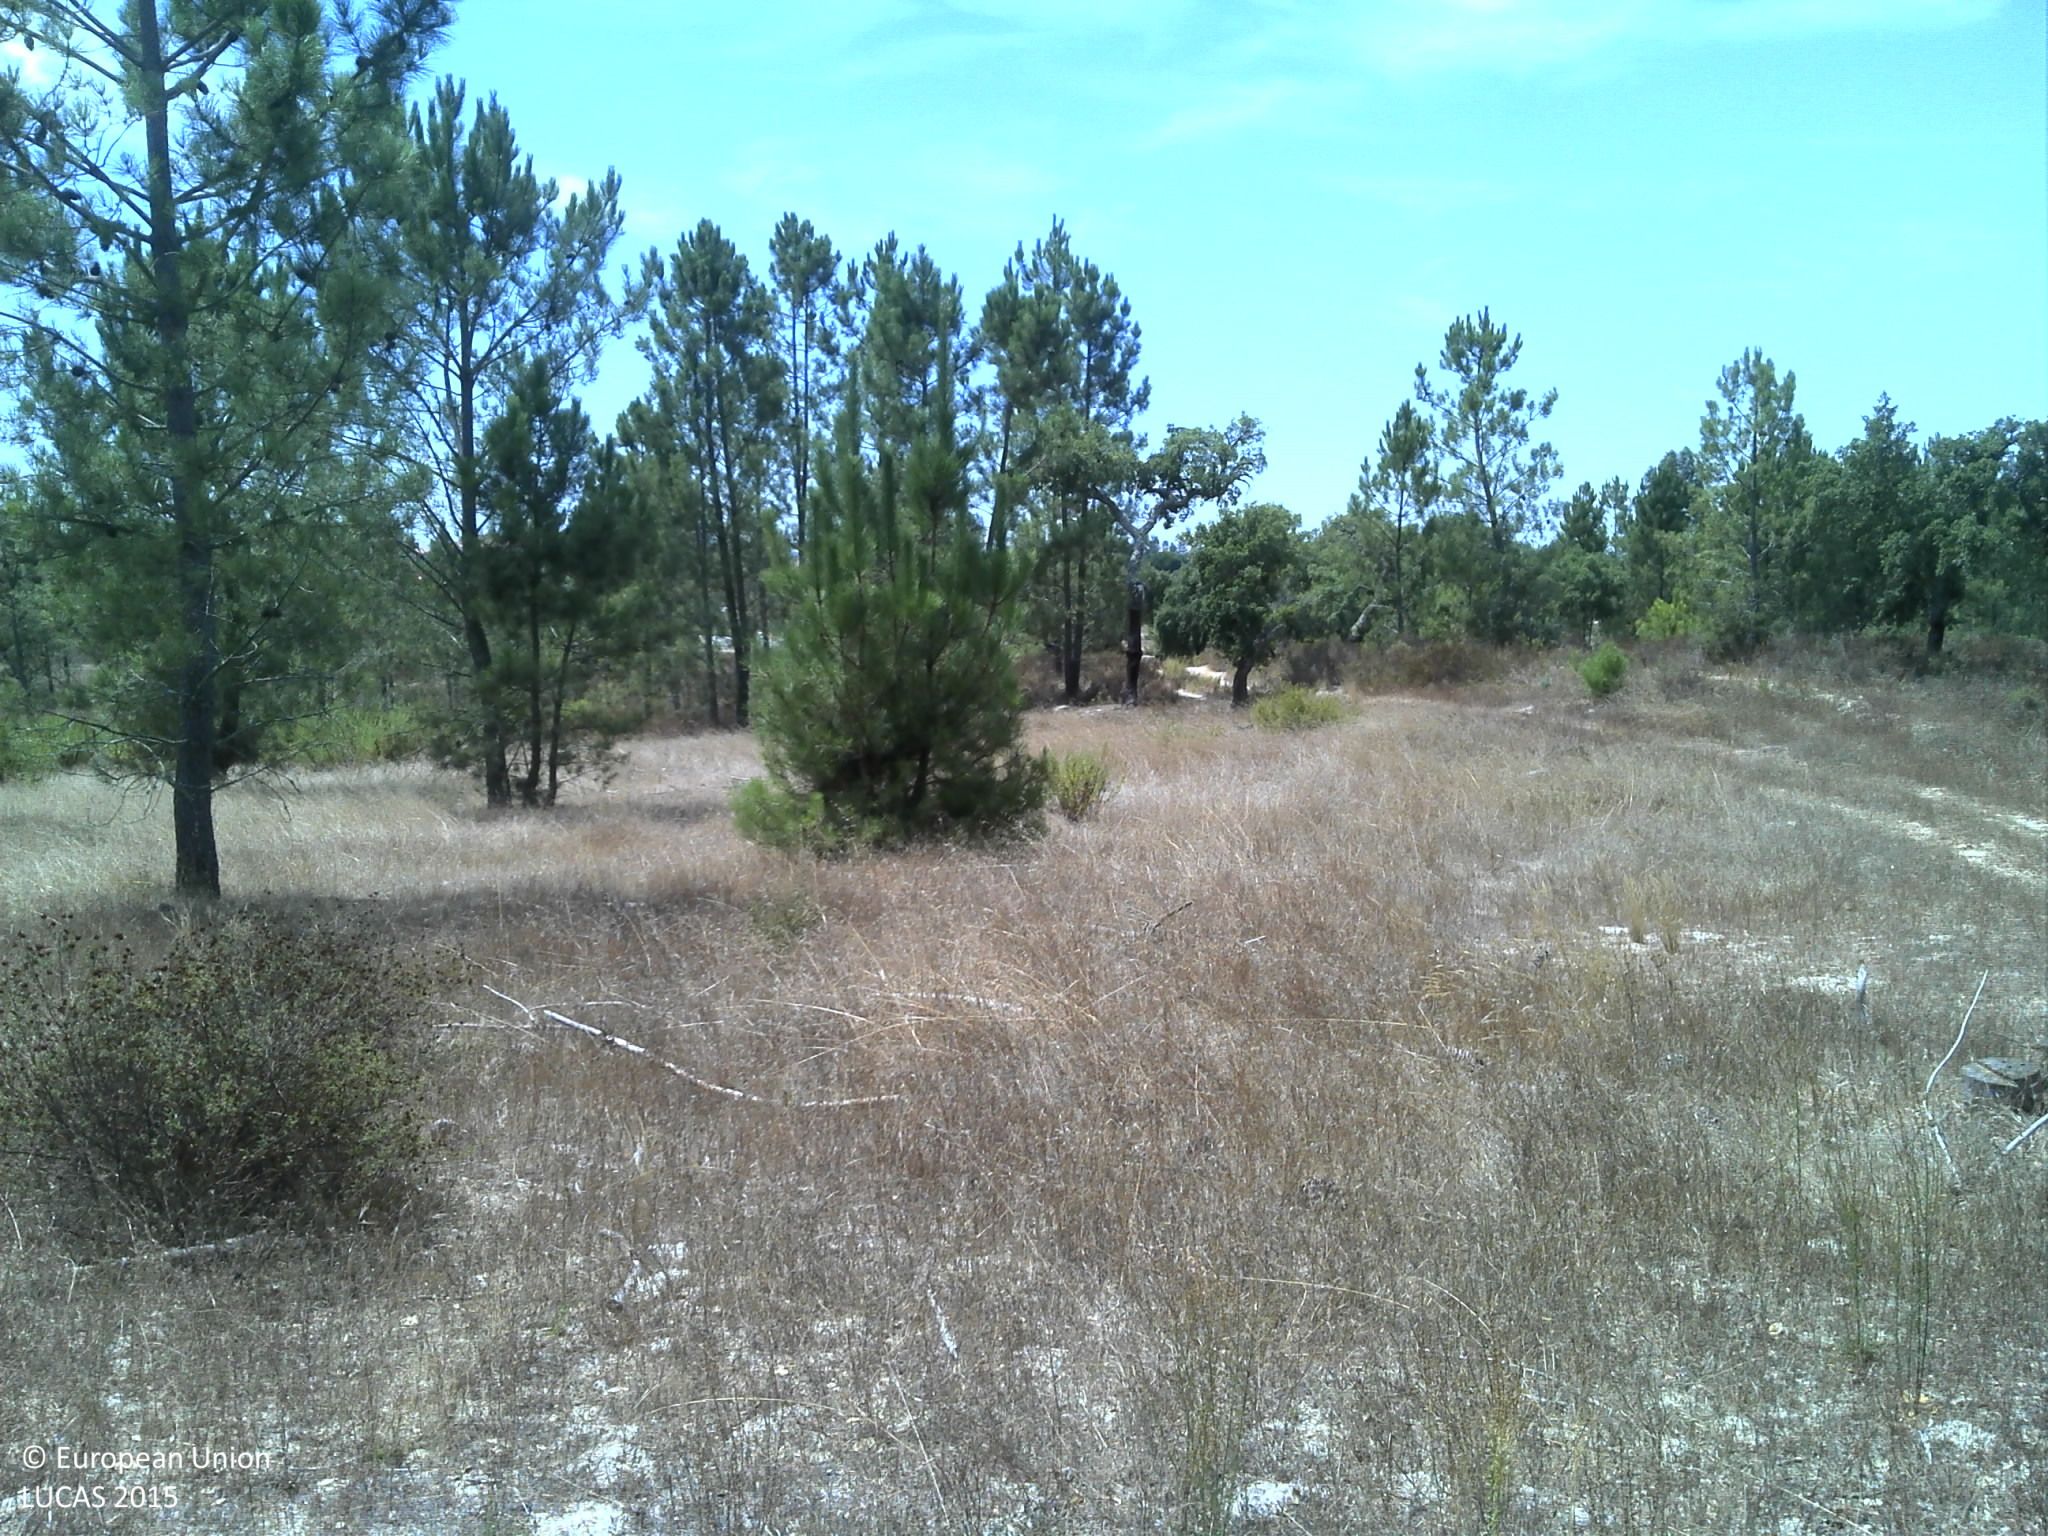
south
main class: Woodland
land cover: Broadleaved woodland
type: broadleaved evergreen forest
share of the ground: 25 - 50 %
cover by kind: broadleaved forest trees 45 %, herbaceous plants 40 %, unconsolidated bare surface 15 %
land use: Forestry
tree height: > 5 m
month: August
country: PT
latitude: 38.8324
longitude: -8.5499
